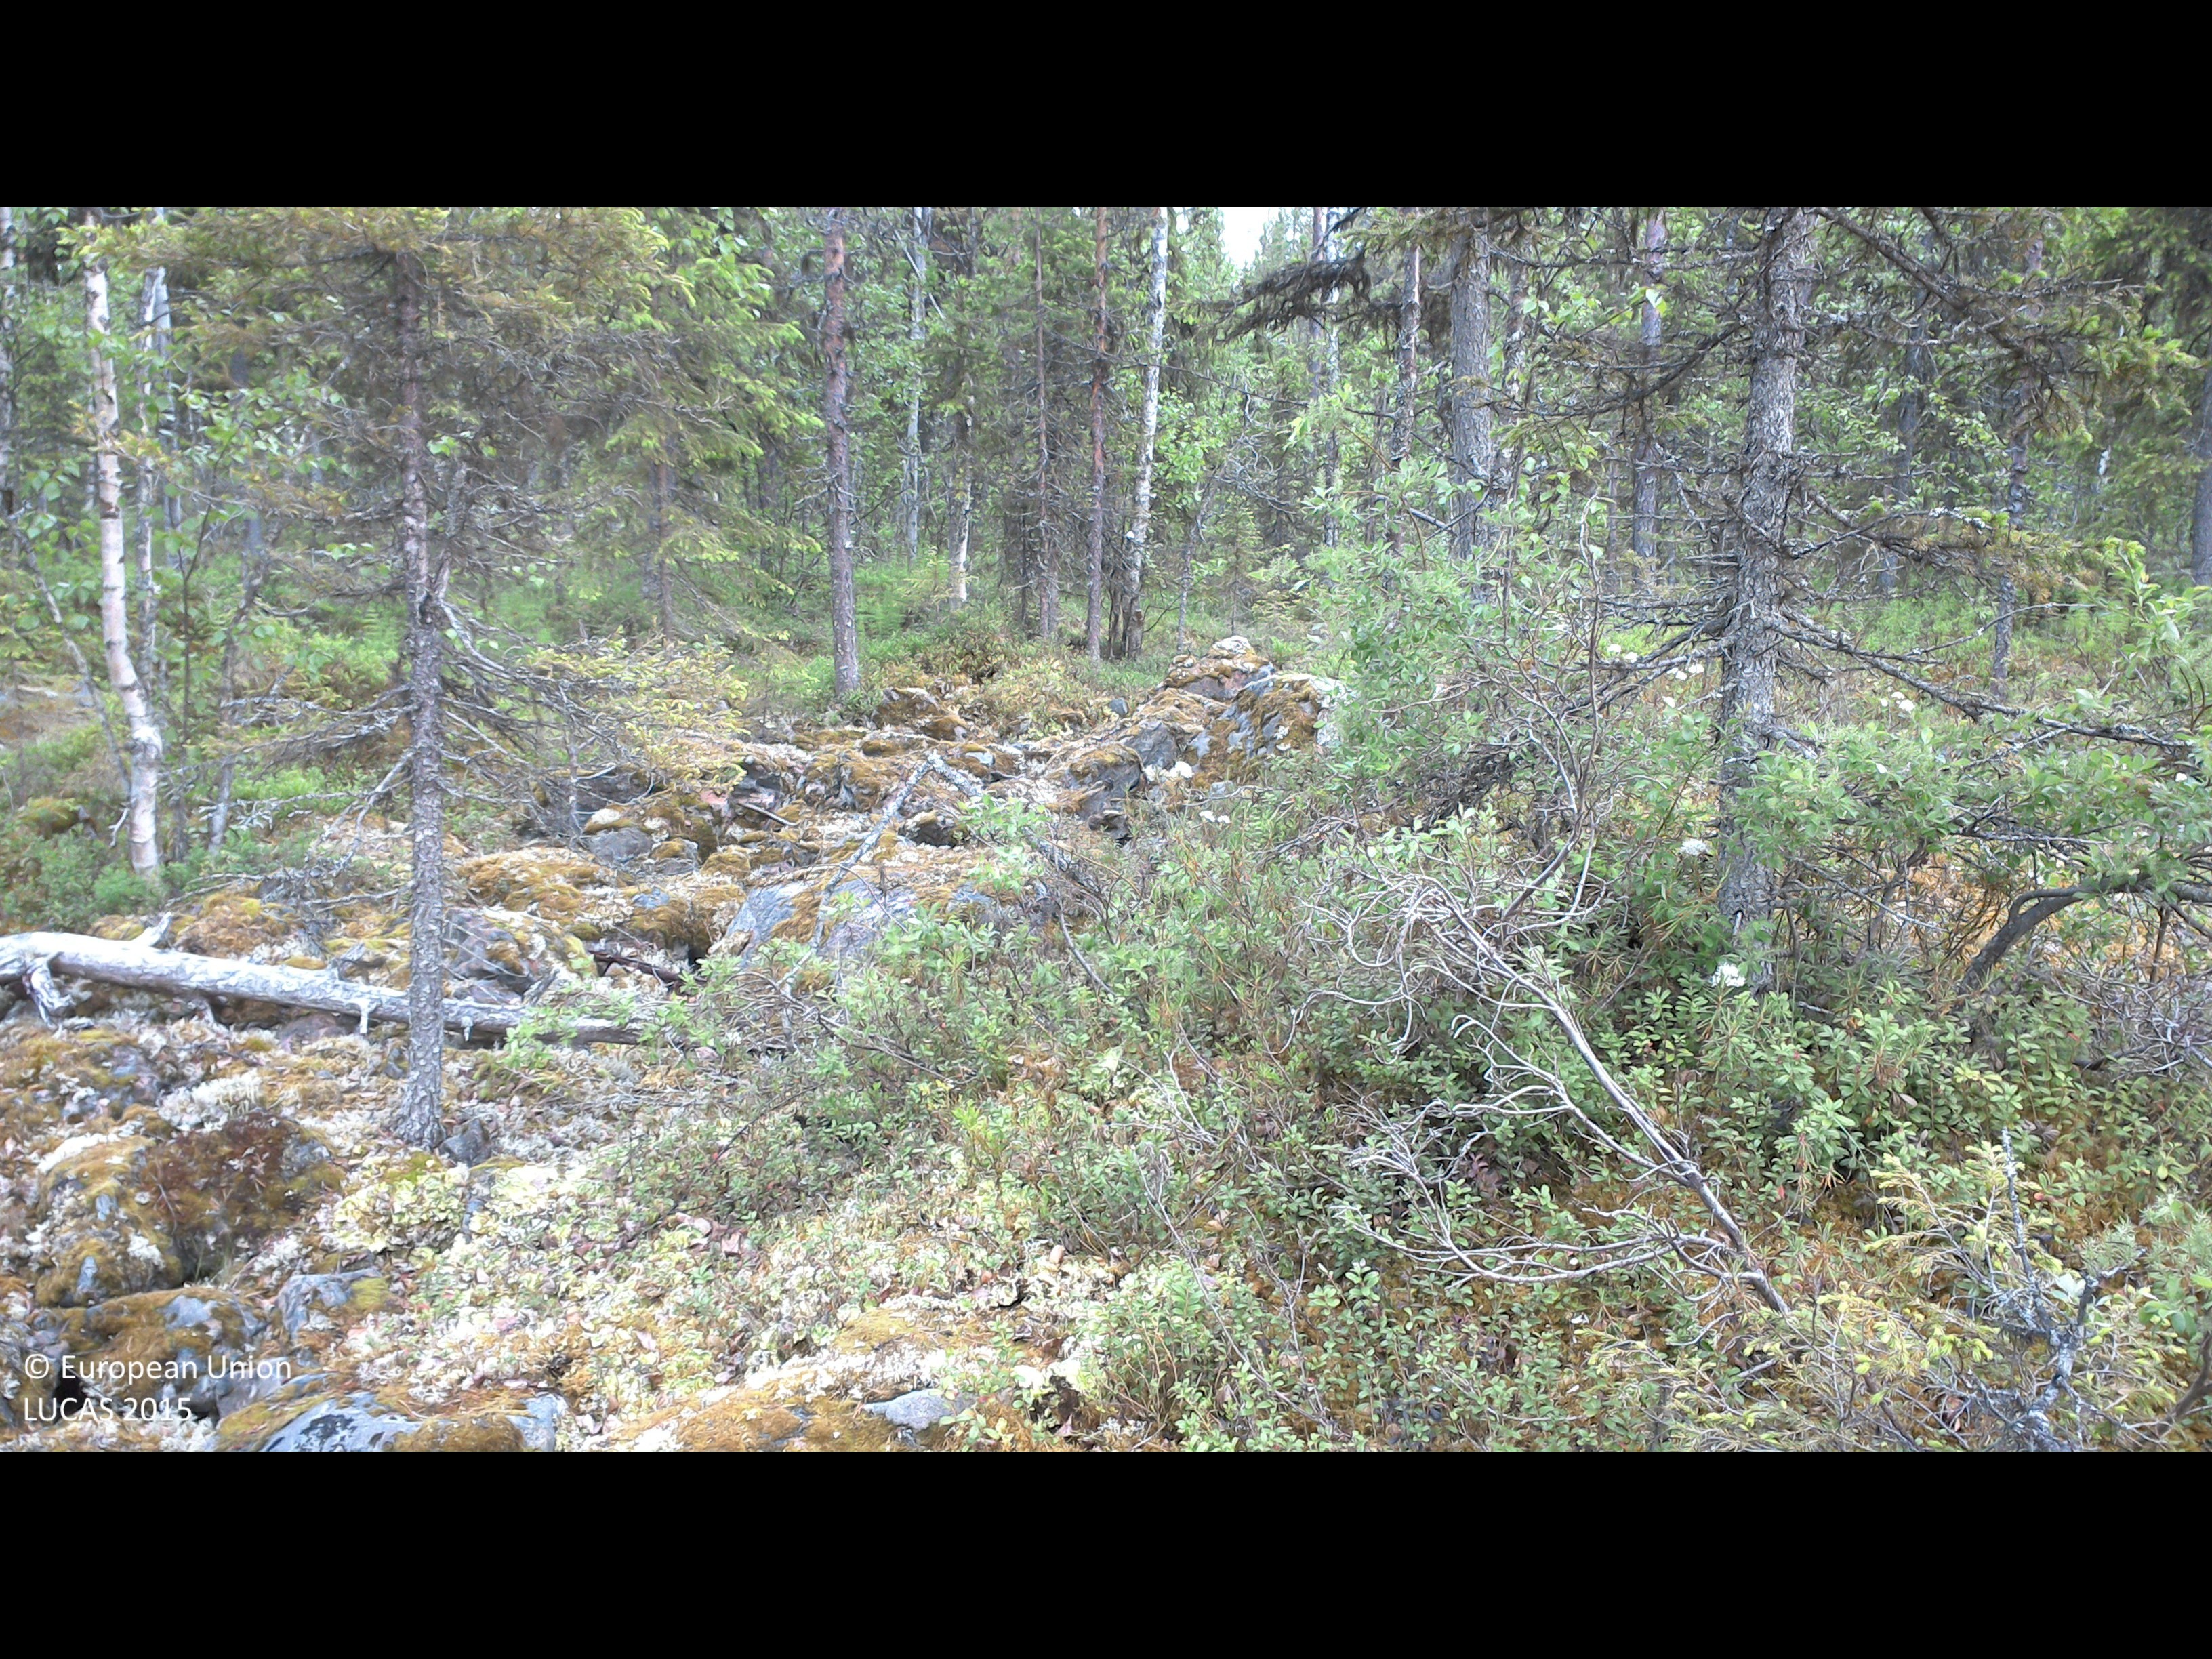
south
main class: Woodland
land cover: Spruce dominated coniferous woodland
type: boreal forest
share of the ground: > 75 %
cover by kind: shrubs 55 %, lichens and mosses 20 %, coniferous forest trees 15 %, broadleaved forest trees 5 %, unconsolidated bare surface 5 %
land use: Forestry
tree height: > 5 m
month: June
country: SE
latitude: 66.9165
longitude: 22.6991
